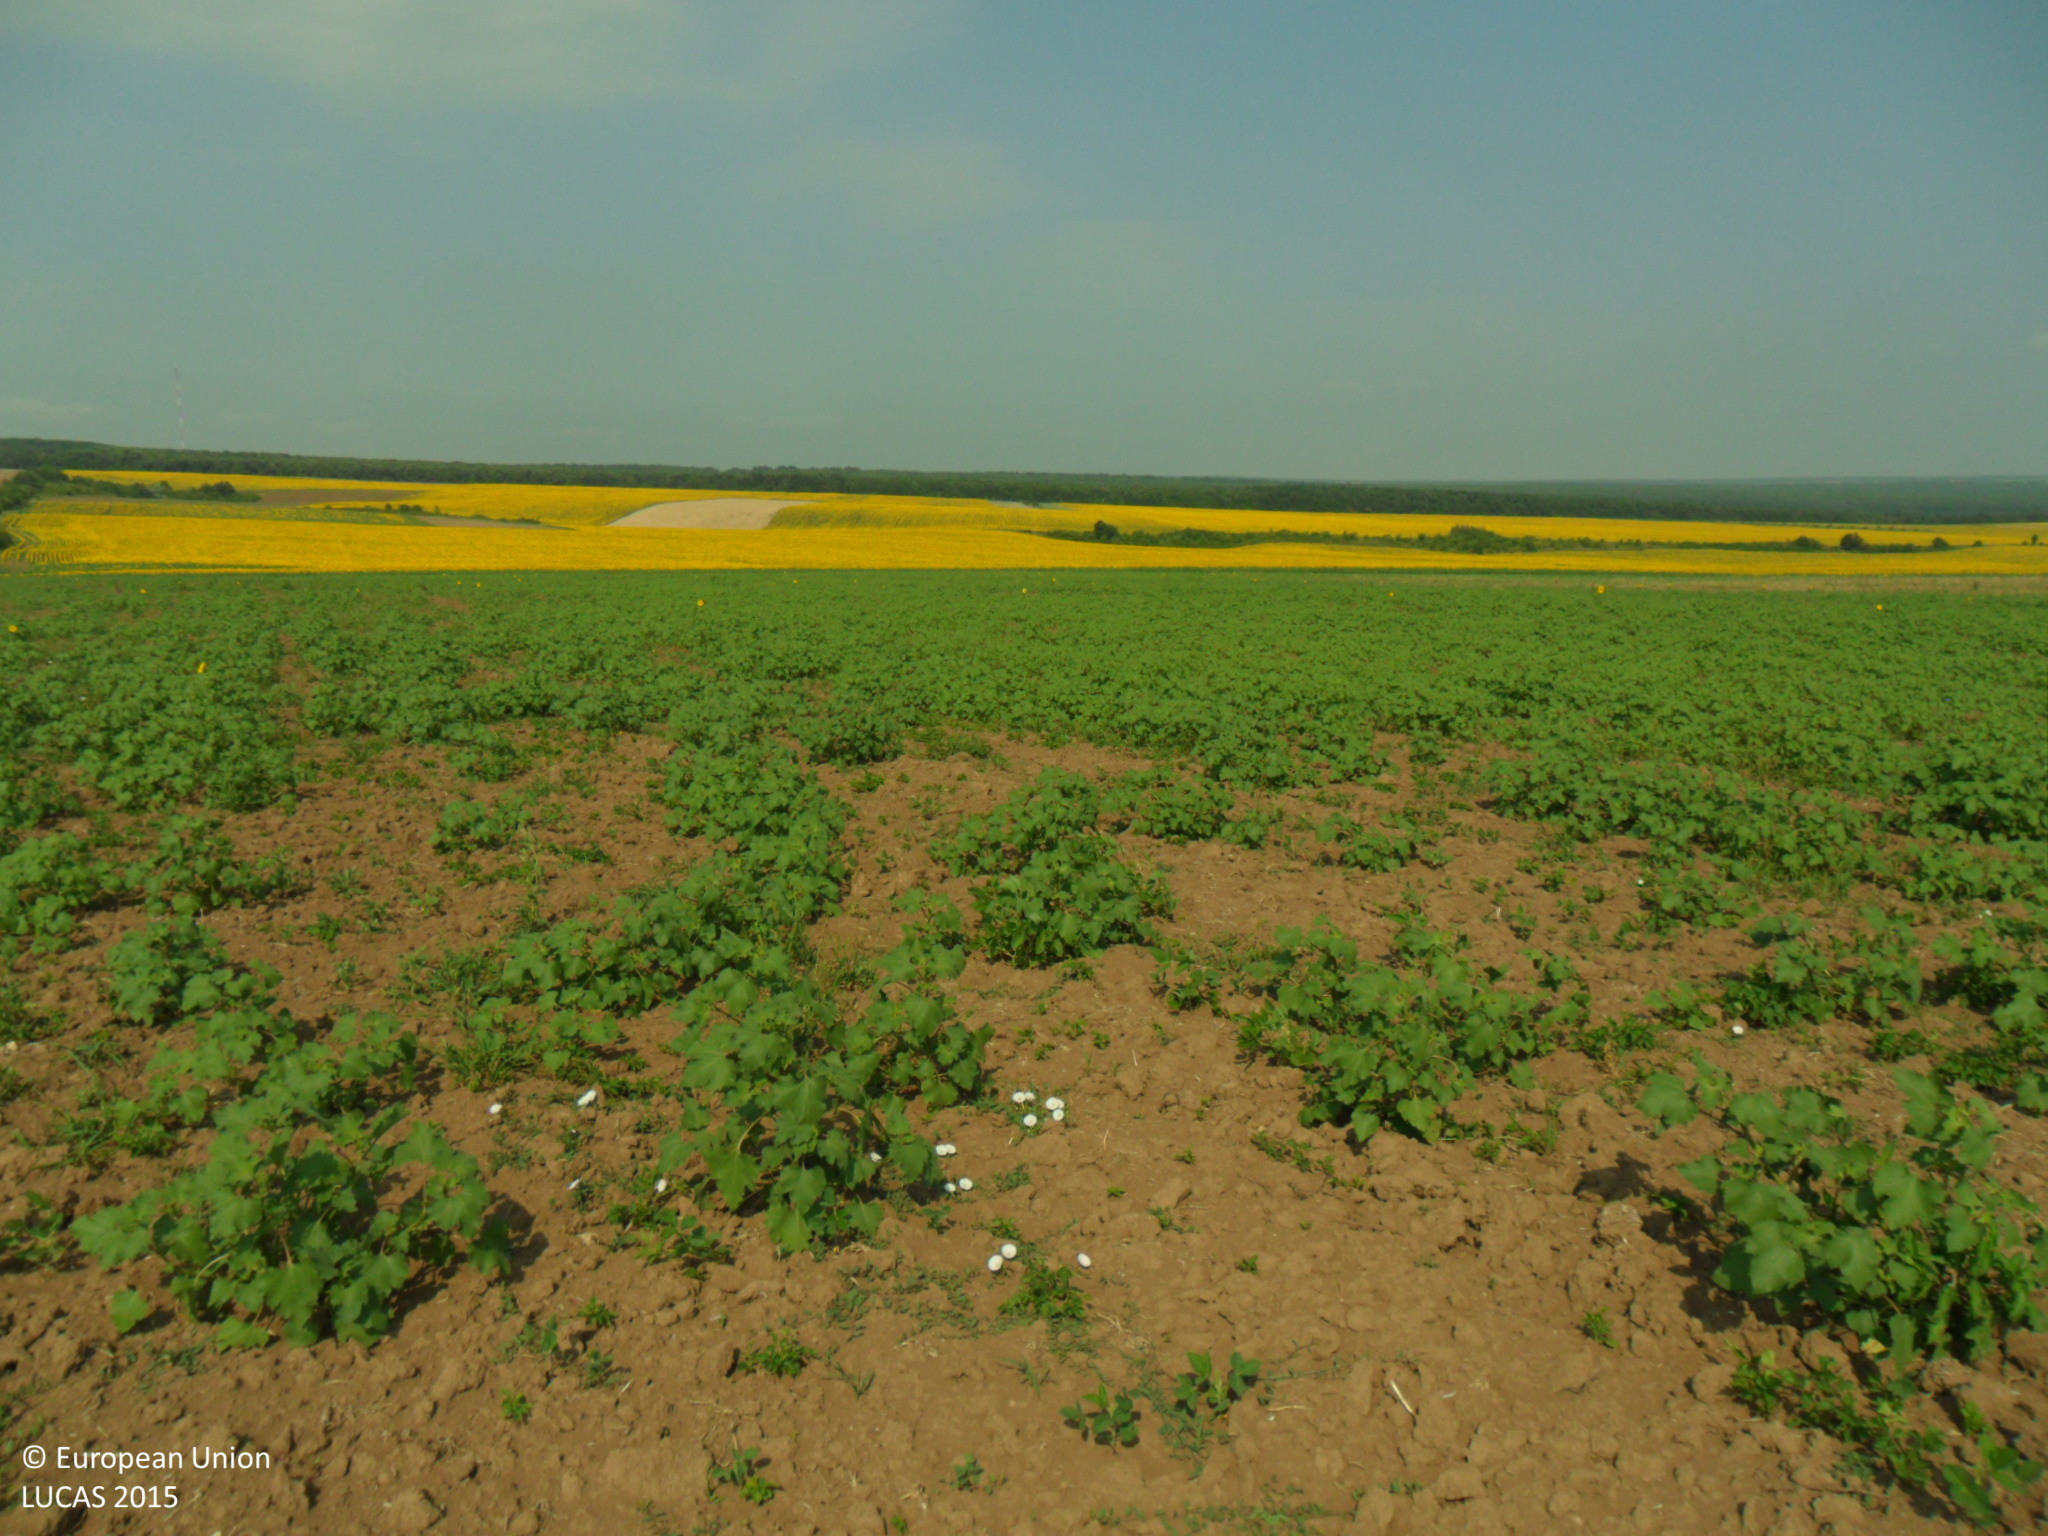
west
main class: Cropland
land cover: Soya
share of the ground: 25 - 50 %
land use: Agriculture (excluding fallow land and kitchen gardens)
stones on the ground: < 10 %
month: July
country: BG
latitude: 43.5137
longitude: 26.9523
